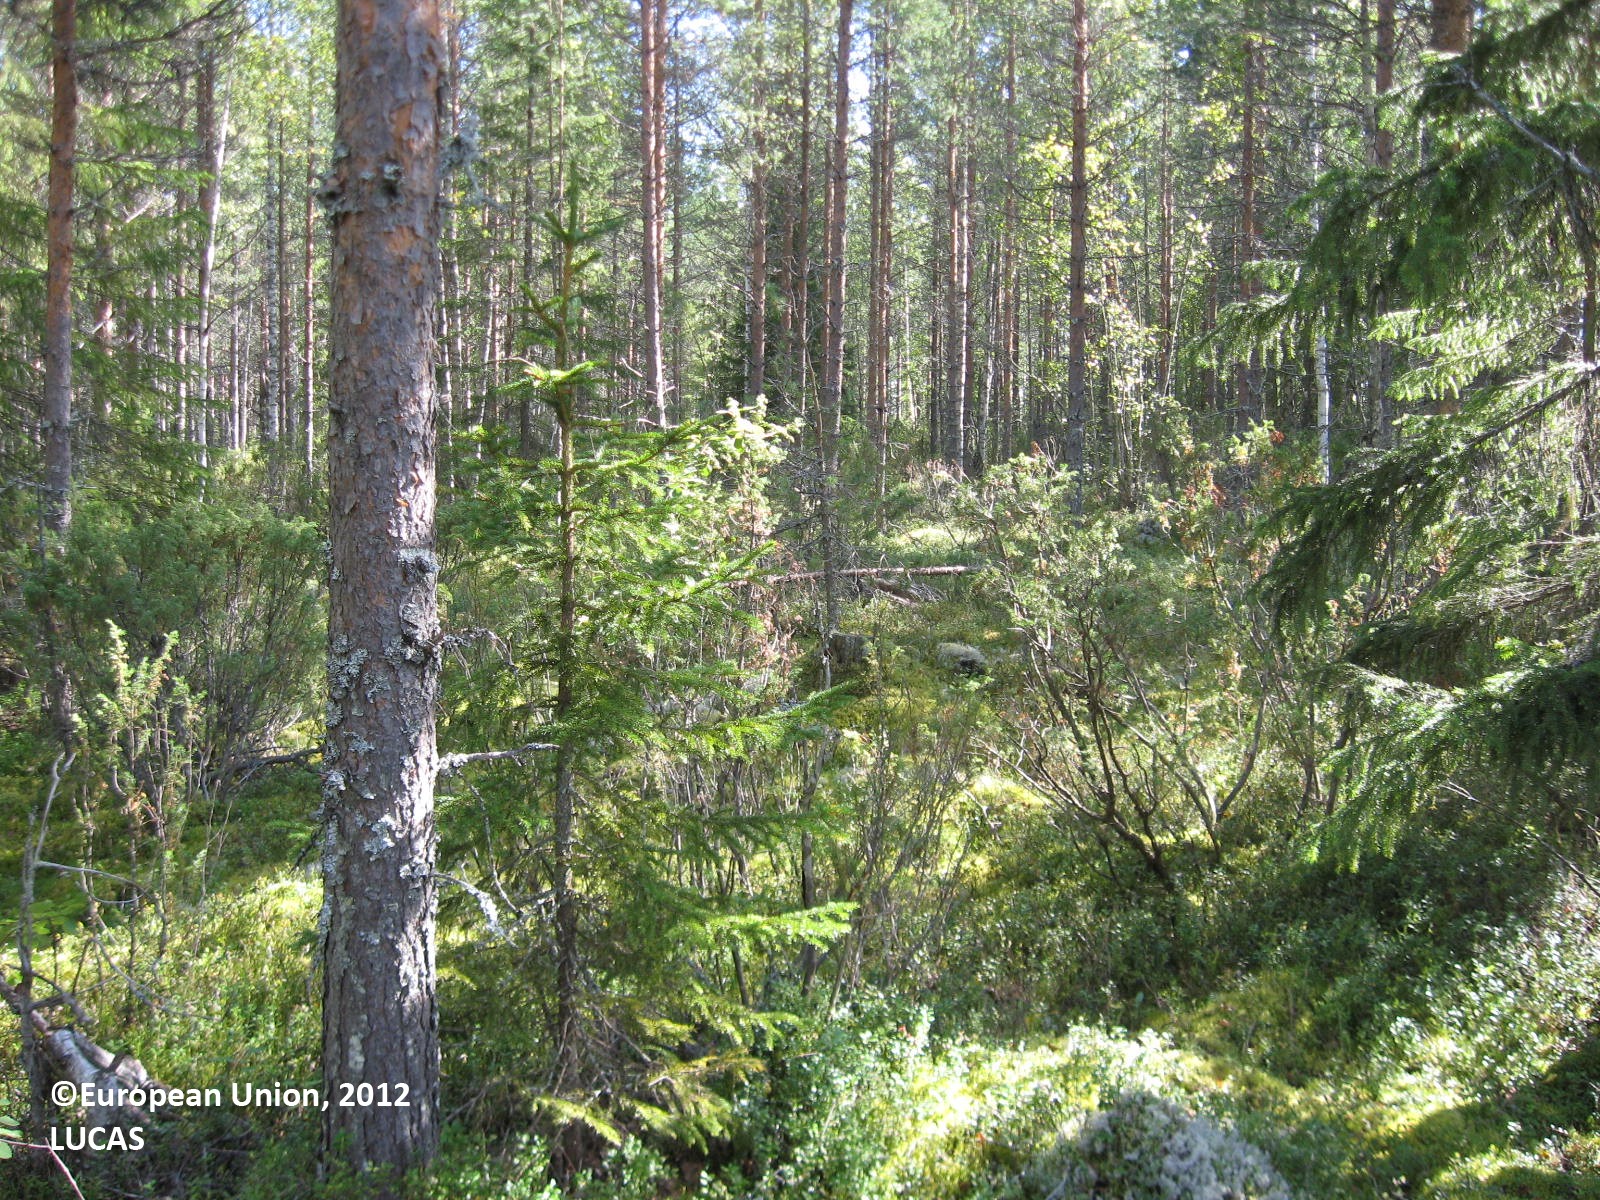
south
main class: Woodland
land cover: Pine dominated coniferous woodland
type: boreal forest
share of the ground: > 75 %
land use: Forestry
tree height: > 5 m
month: August
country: FI
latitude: 63.6454
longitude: 29.7179
